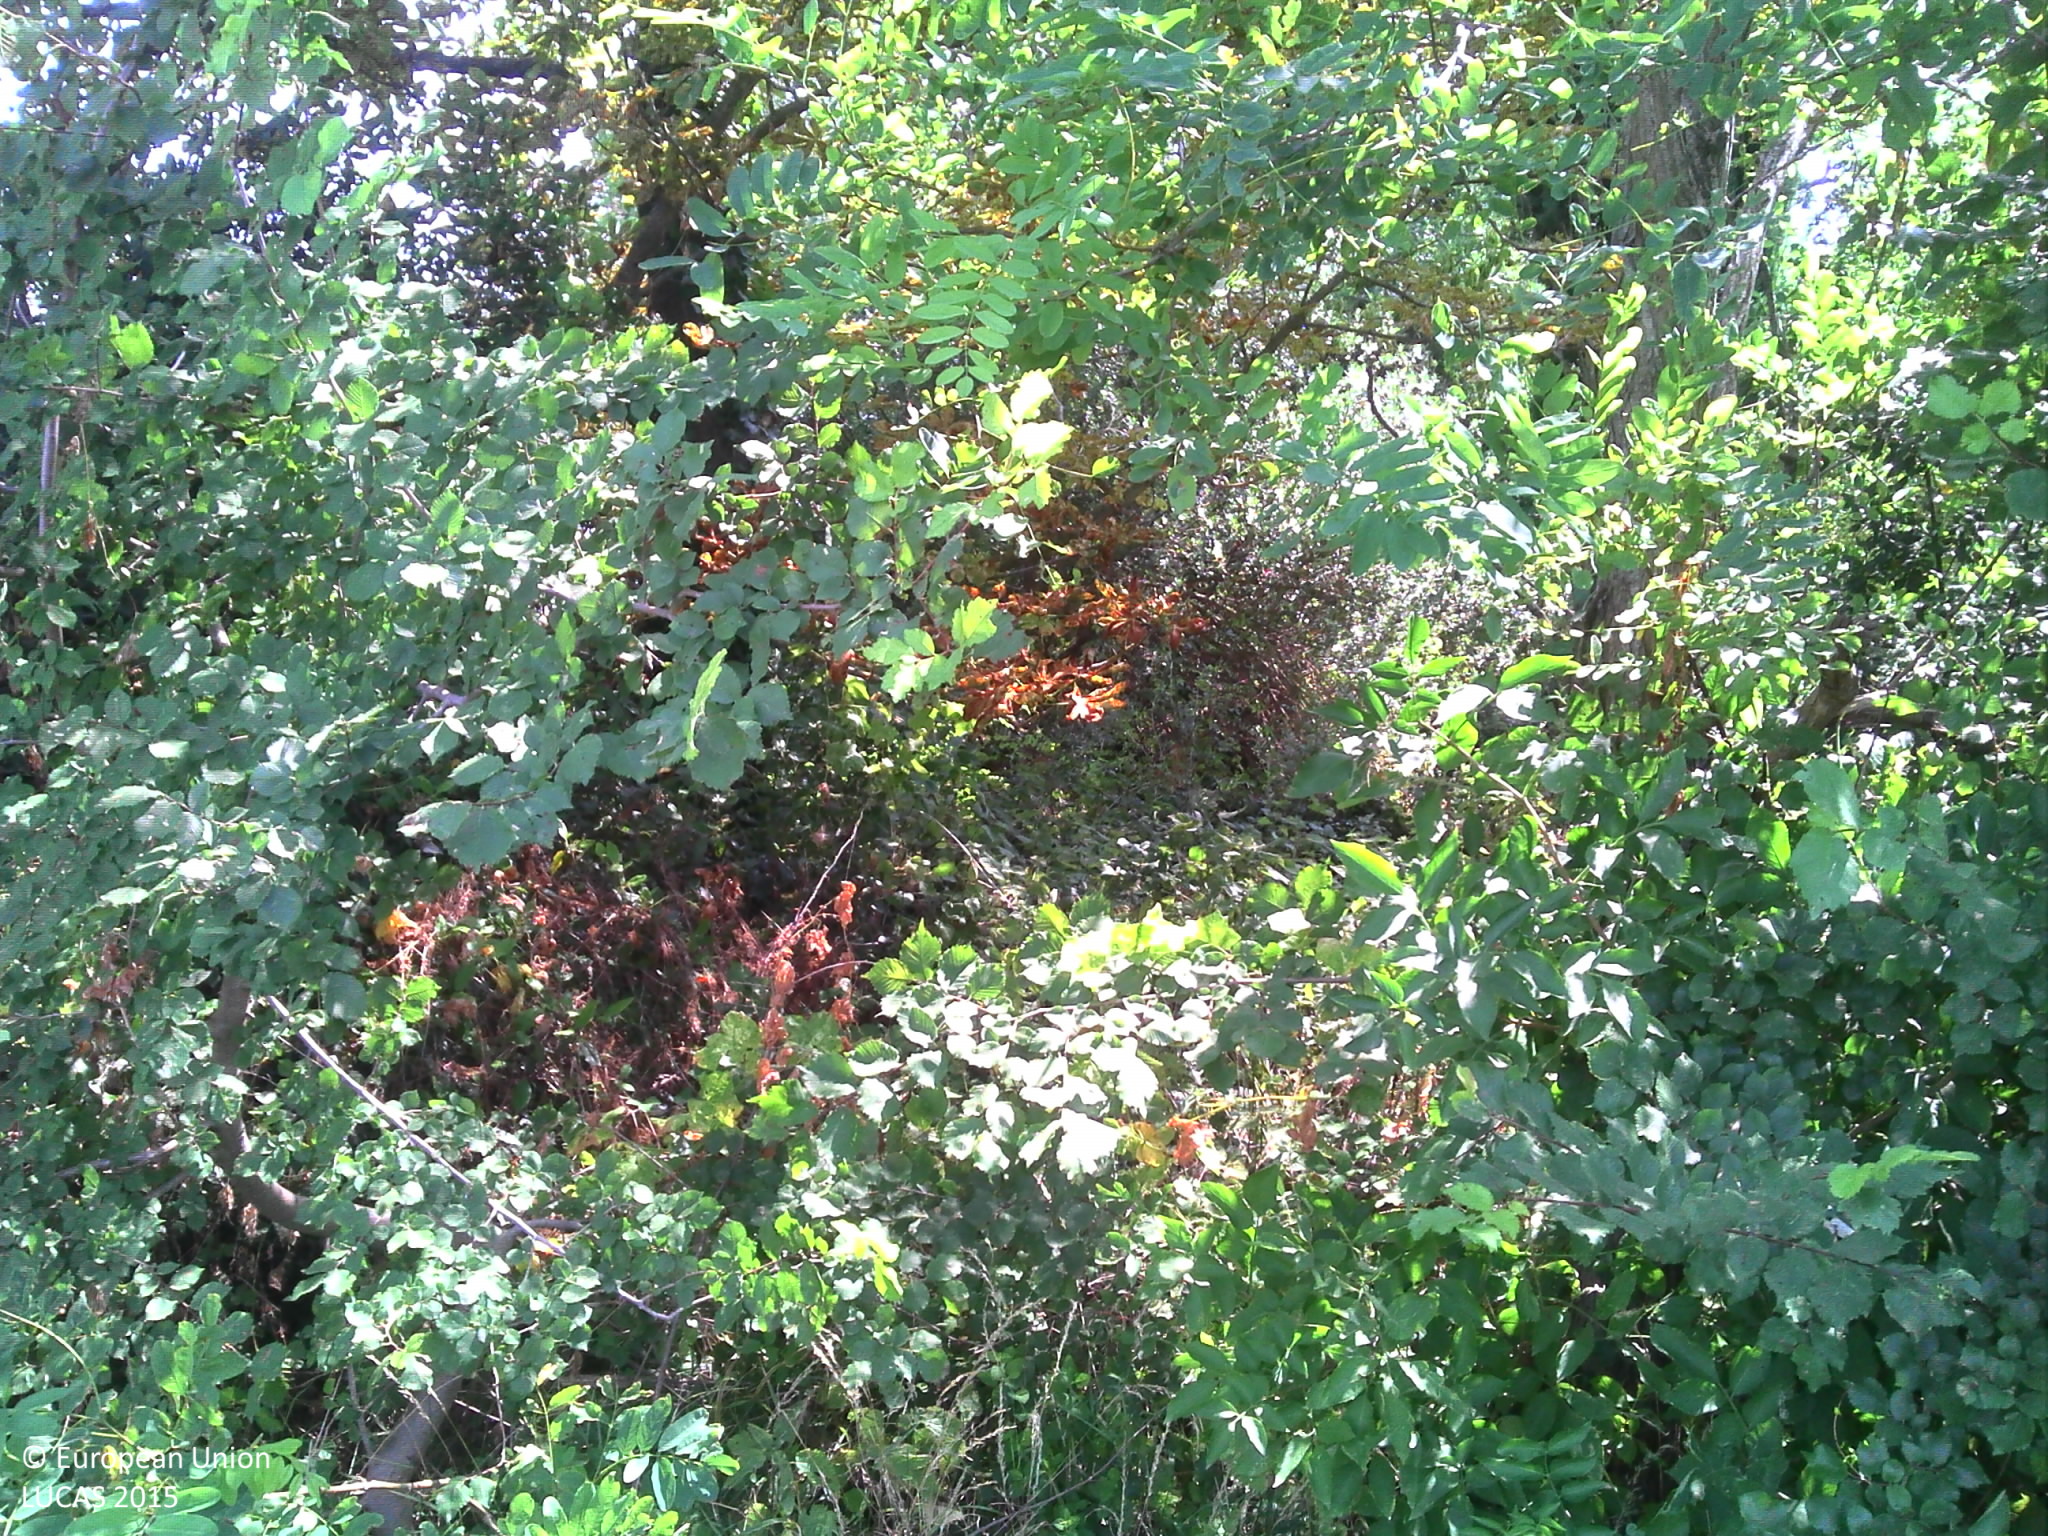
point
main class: Woodland
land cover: Pine dominated mixed woodland
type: thermophilous deciduous forest
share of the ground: > 75 %
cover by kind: broadleaved forest trees 75 %, coniferous forest trees 25 %
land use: Residential
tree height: > 5 m
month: July
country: FR
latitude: 43.1450
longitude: 2.1262
